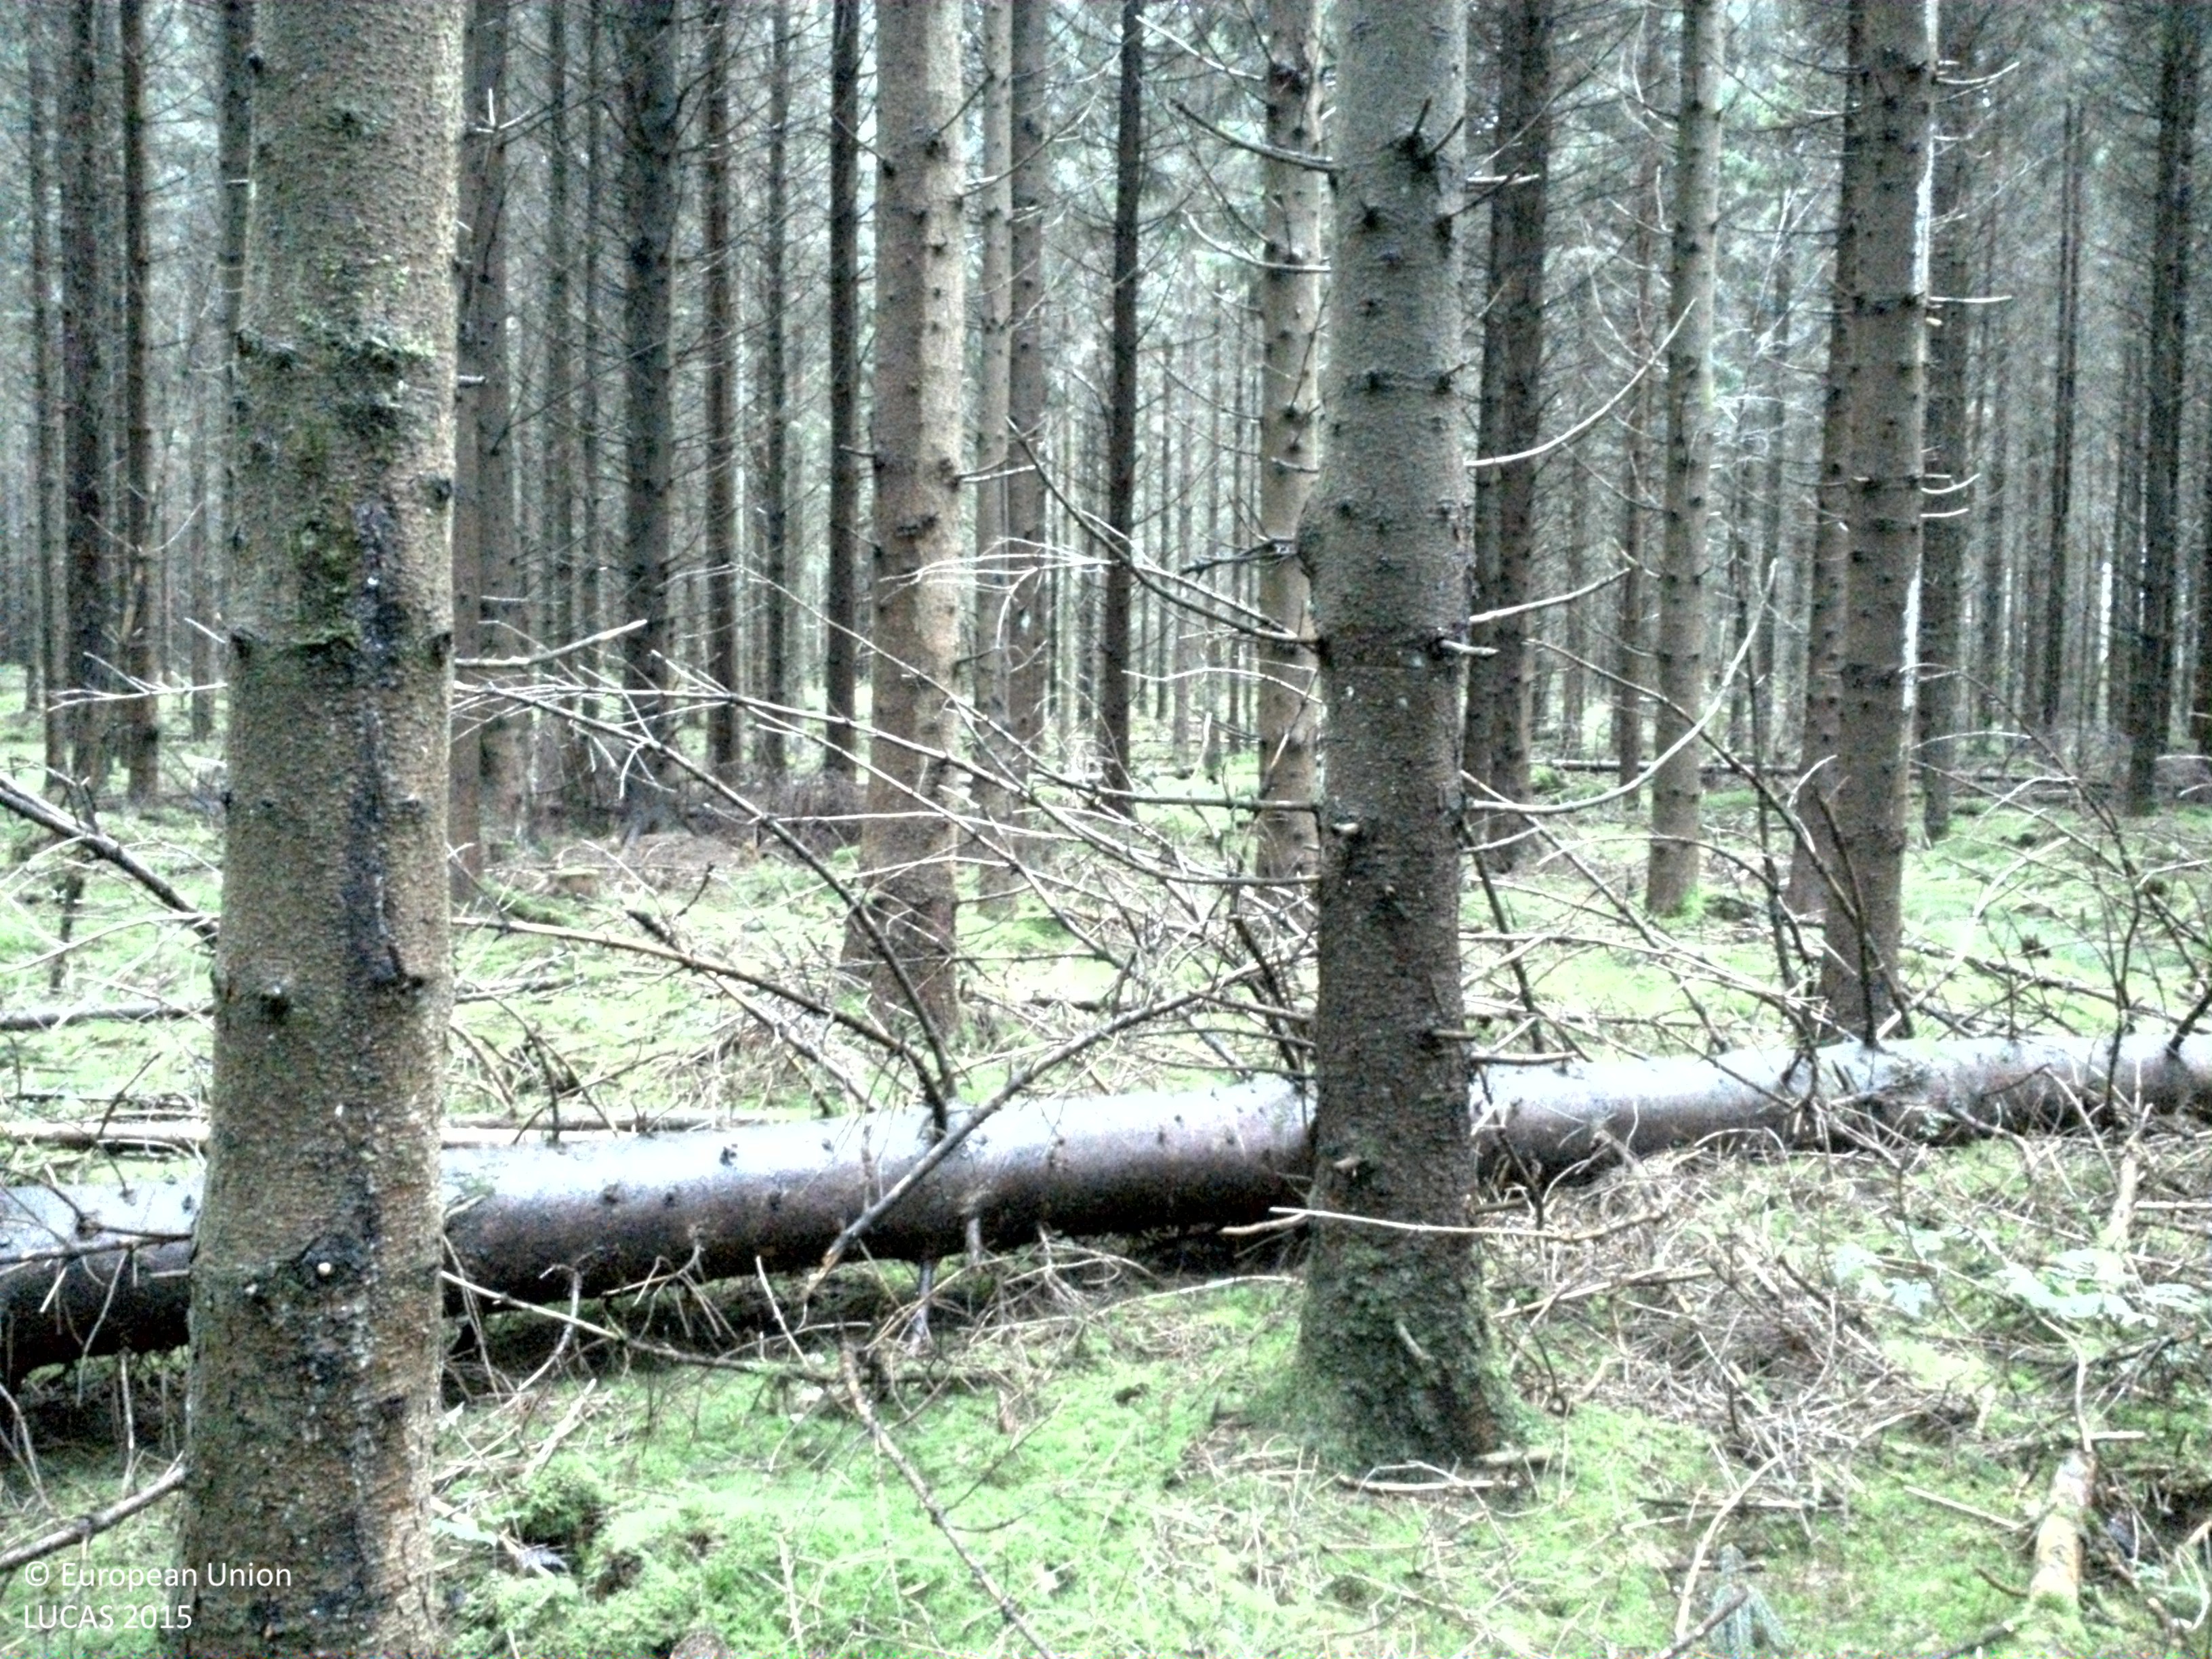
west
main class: Woodland
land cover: Spruce dominated coniferous woodland
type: hemiboreal forest and nemoral coniferous forest and mixed broadleaved-coniferous forest
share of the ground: > 75 %
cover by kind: coniferous forest trees 85 %, lichens and mosses 10 %, herbaceous plants 5 %
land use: Forestry
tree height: > 5 m
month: November
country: SE
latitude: 56.2385
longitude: 13.1758
